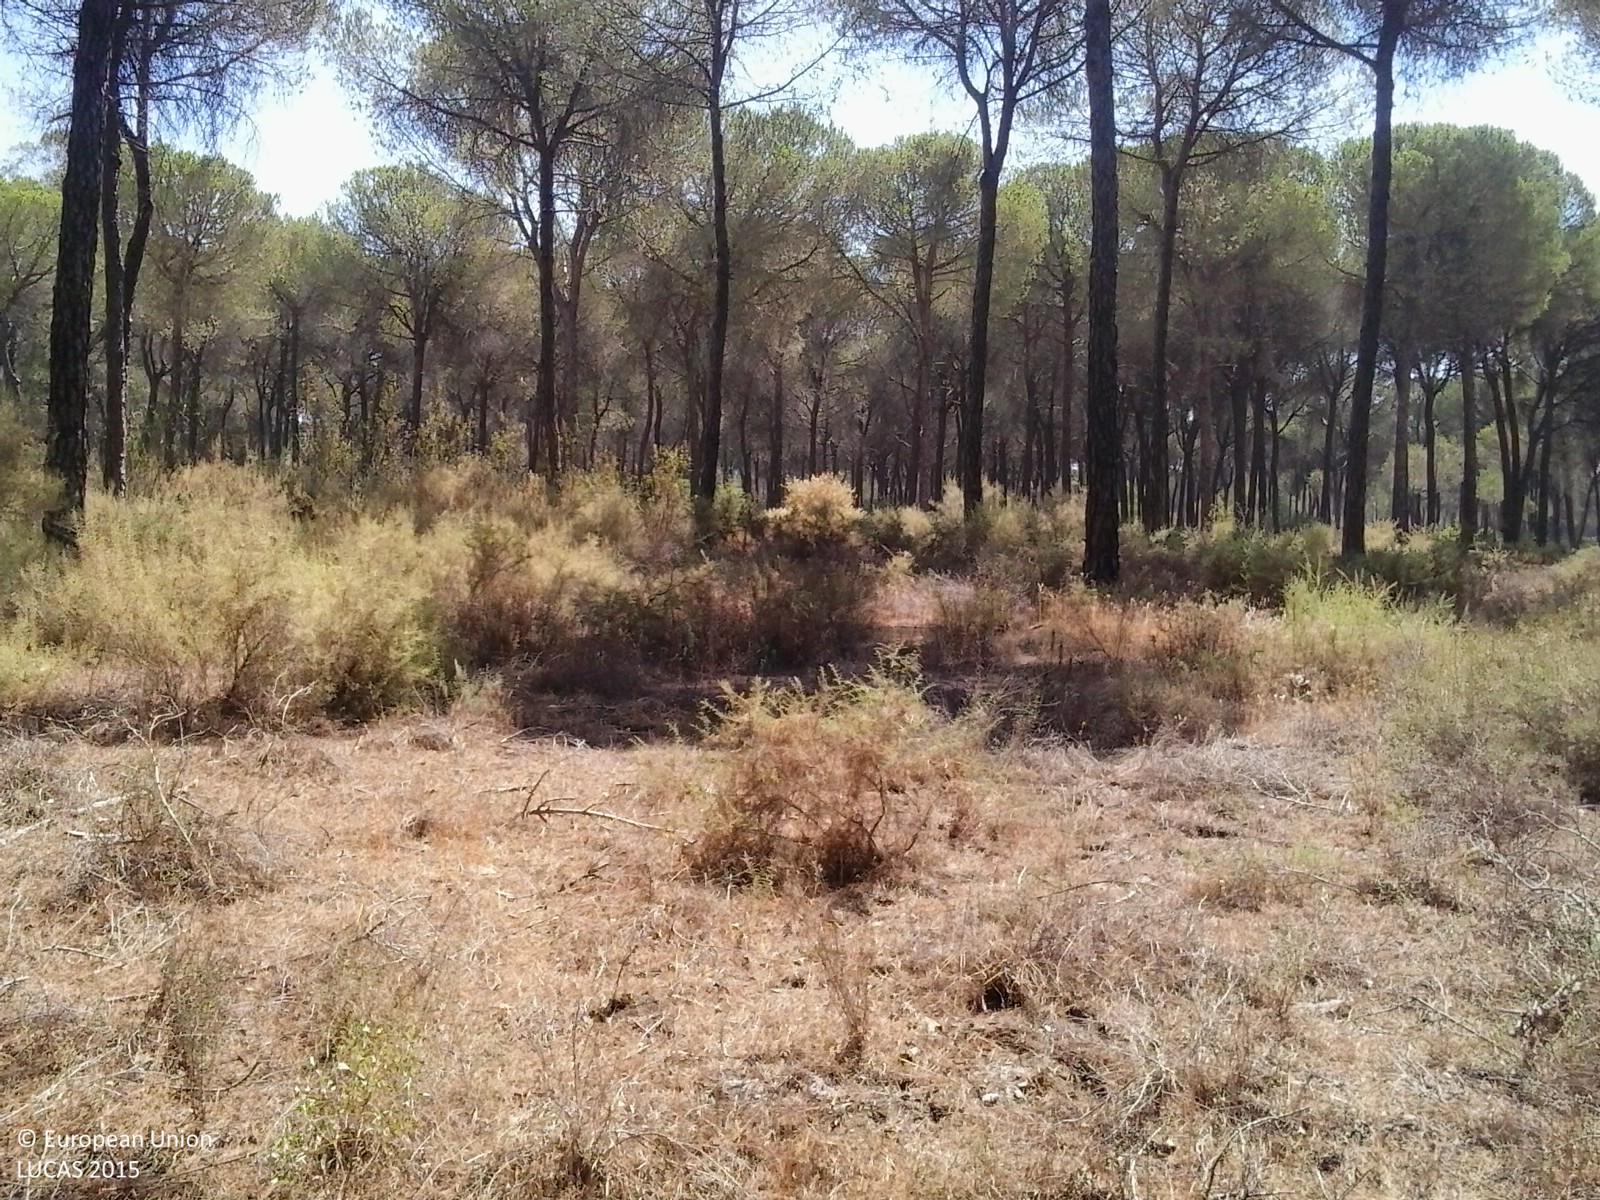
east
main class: Woodland
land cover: Pine dominated coniferous woodland
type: coniferous forest of the mediterranean region
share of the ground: > 75 %
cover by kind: coniferous forest trees 75 %, herbaceous plants 15 %, shrubs 10 %
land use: Forestry
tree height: > 5 m
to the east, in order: Pine dominated coniferous woodland; Other structural elements; Pine dominated coniferous woodland; Inland fresh water bodies
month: July
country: ES
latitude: 37.2388
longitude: -6.3836
